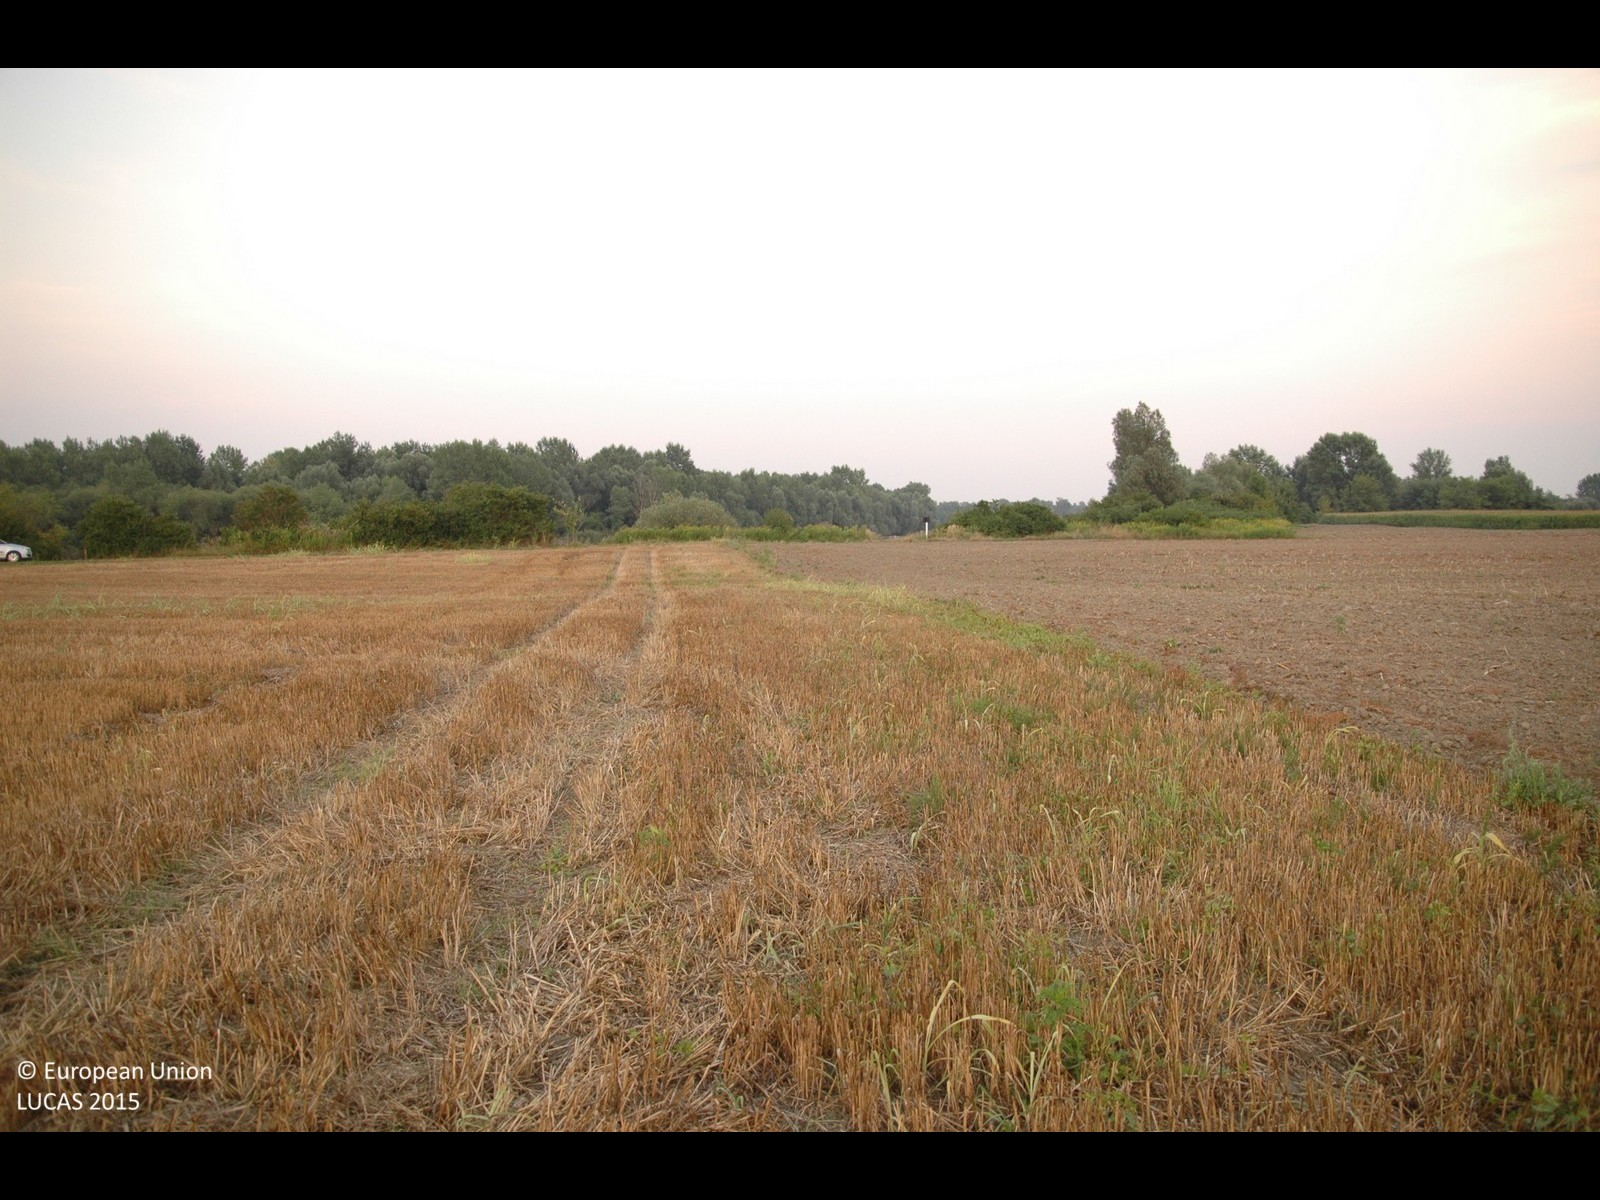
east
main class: Cropland
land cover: Common wheat
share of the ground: > 75 %
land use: Agriculture (excluding fallow land and kitchen gardens)
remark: Harvested field
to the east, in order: Common wheat; Tracks; Abandoned hedges; Inland fresh running water
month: August
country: HR
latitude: 46.2342
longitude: 16.9393
